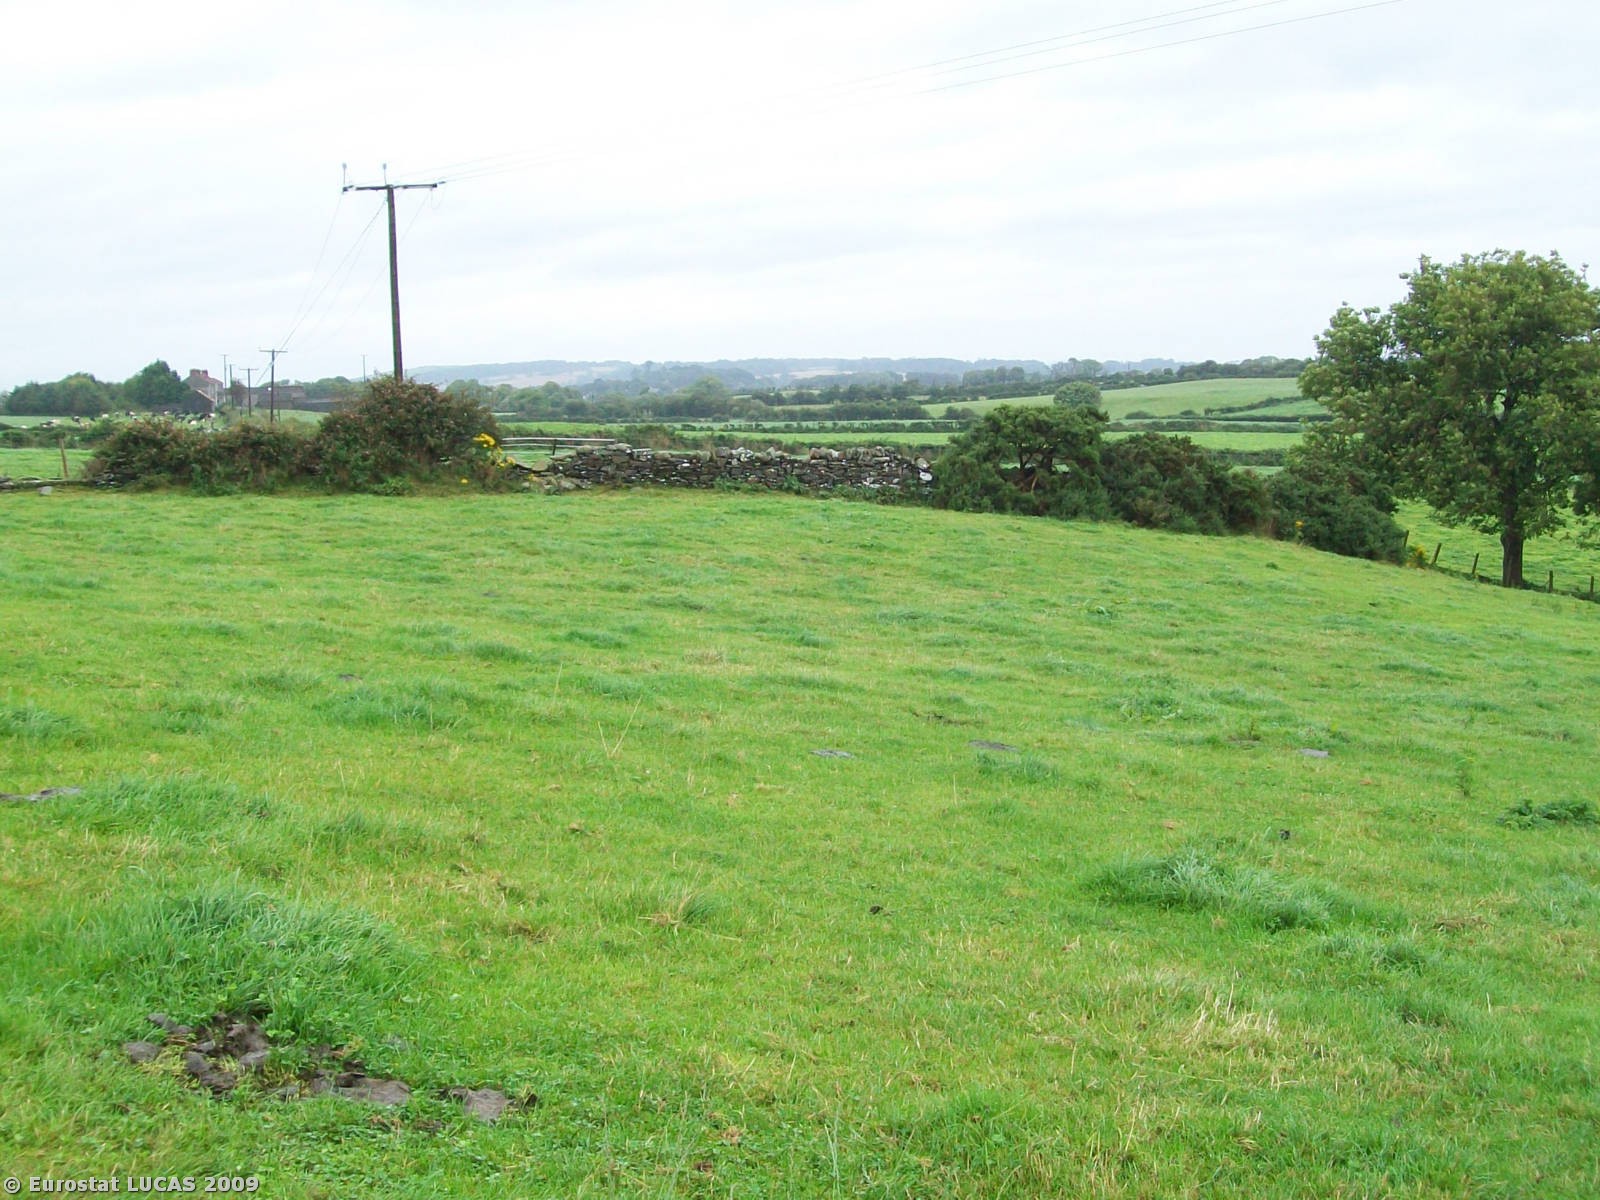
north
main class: Grassland
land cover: Grassland without tree/shrub cover
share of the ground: > 75 %
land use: Agriculture (excluding fallow land and kitchen gardens)
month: August
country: GB
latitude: 54.3492
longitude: -5.5602
